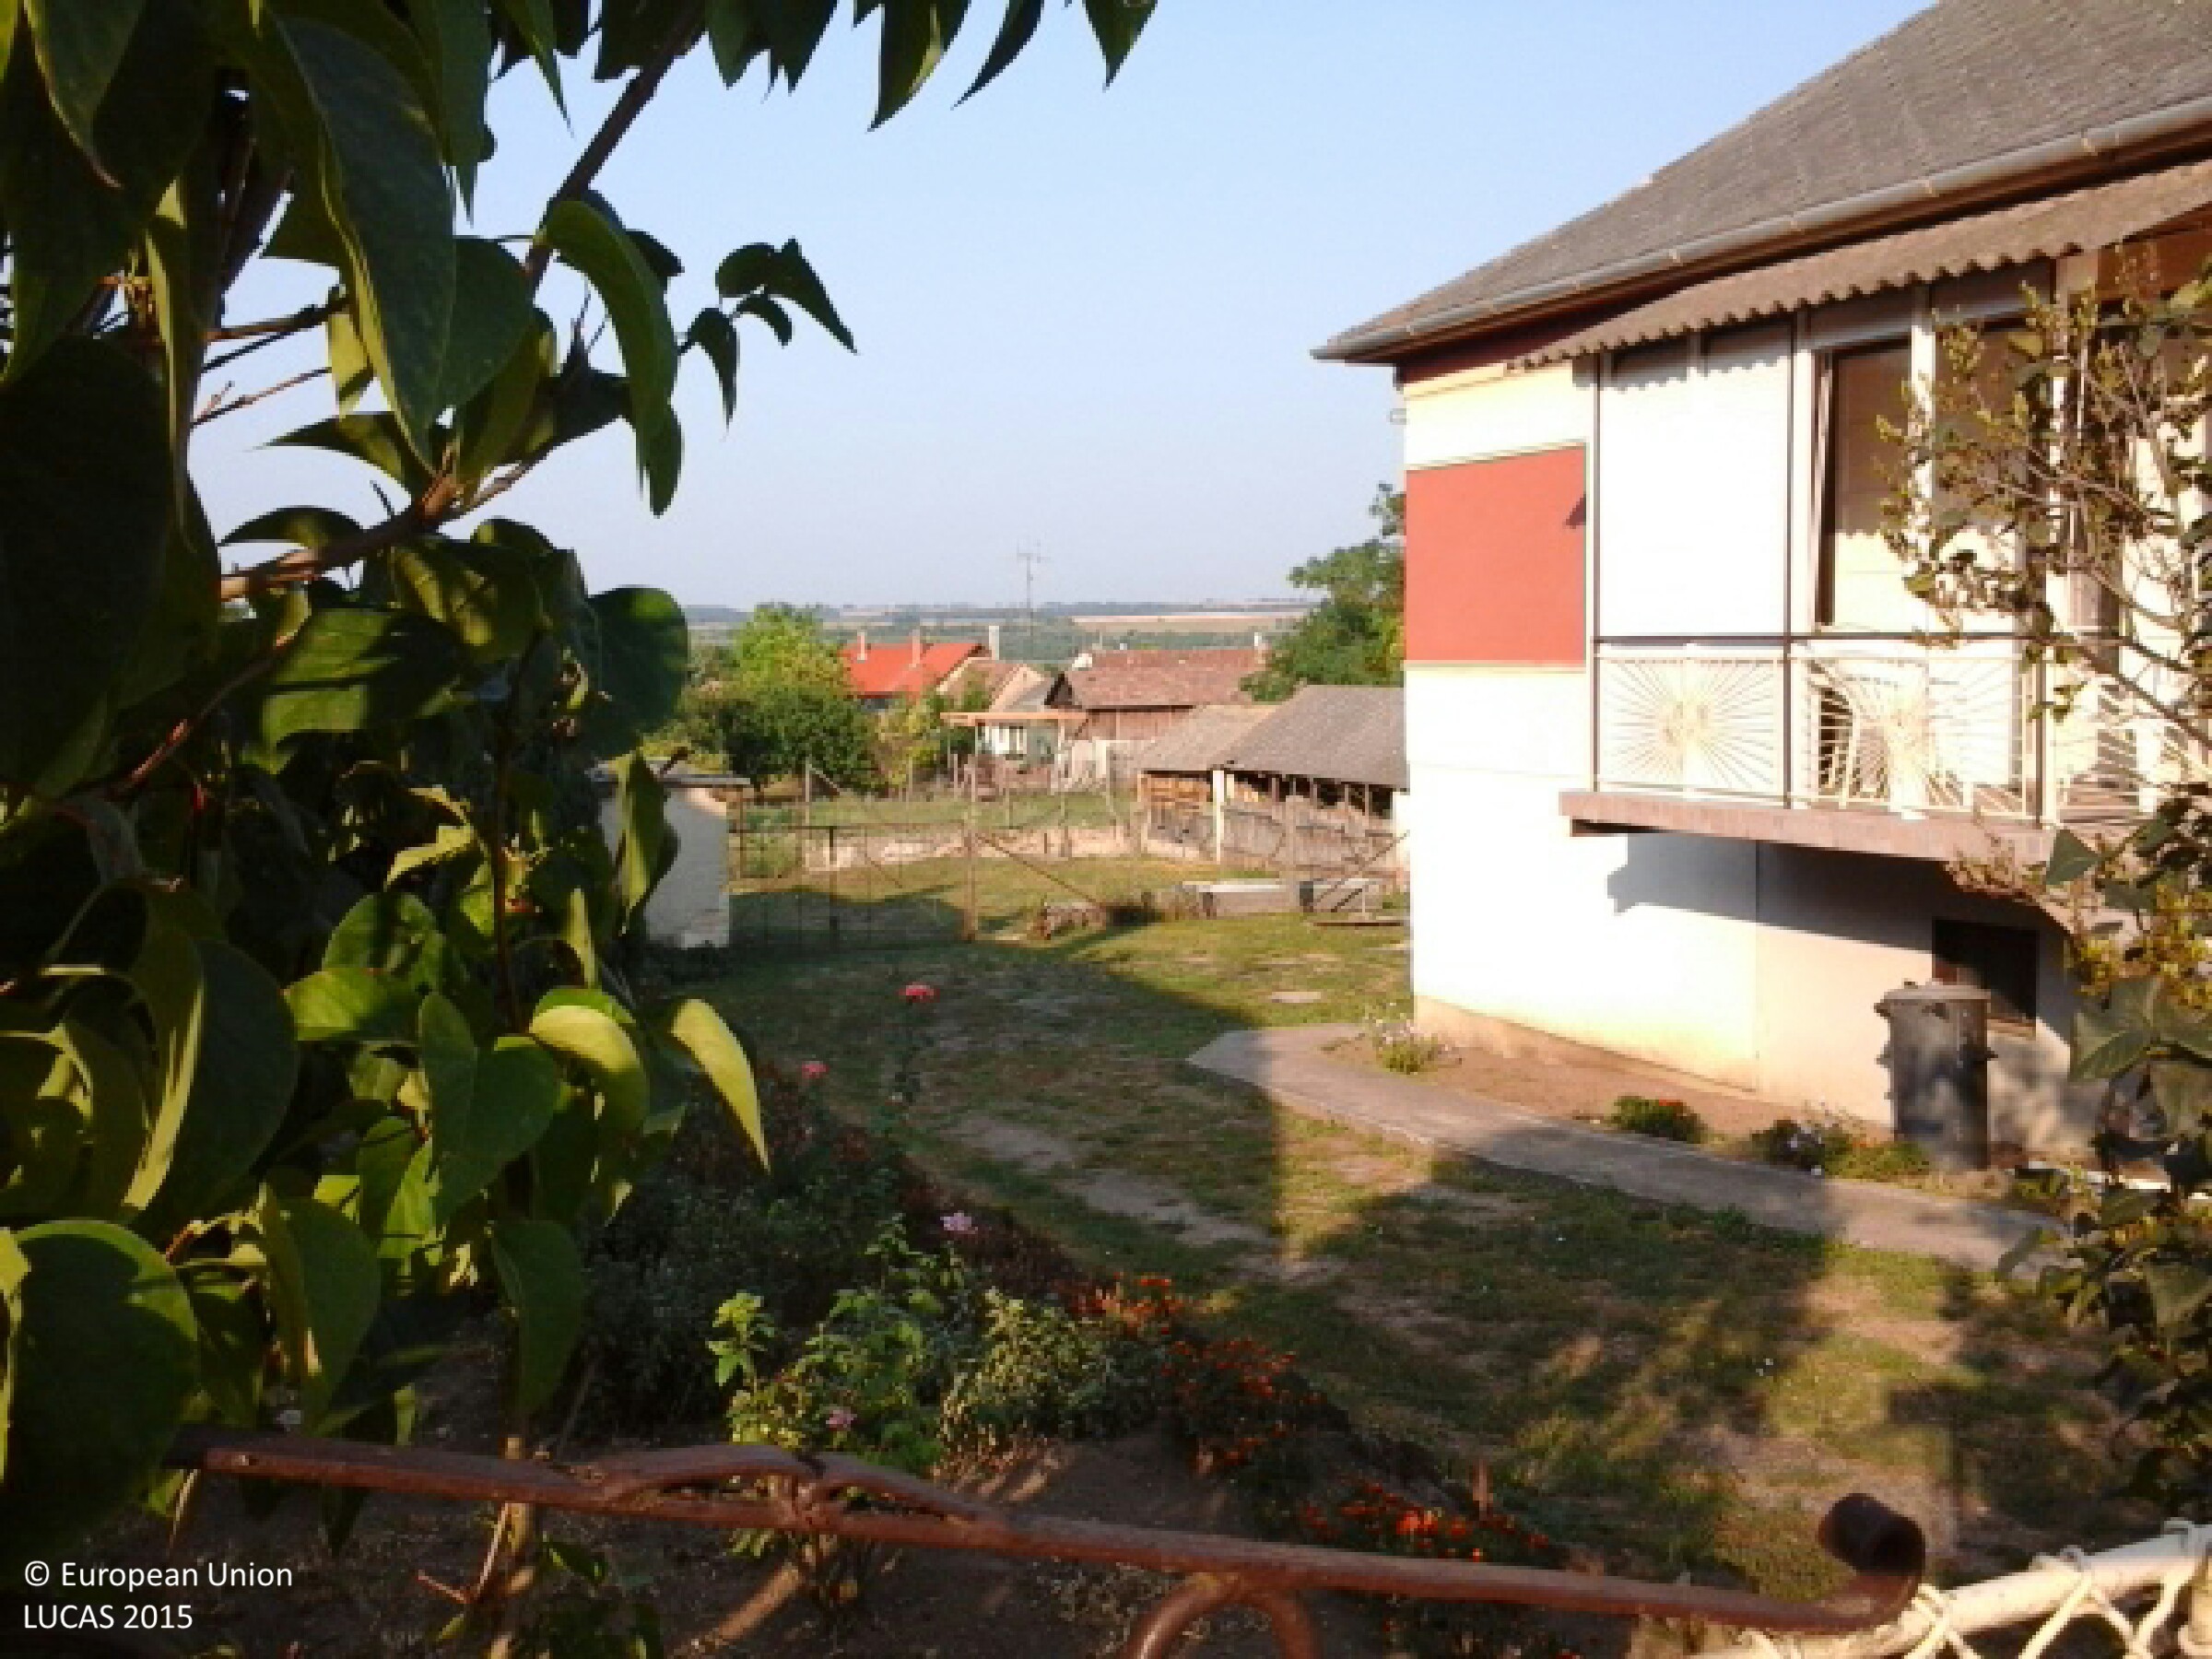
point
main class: Grassland
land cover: Grassland without tree/shrub cover
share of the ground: > 75 %
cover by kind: herbaceous plants 95 %, shrubs 5 %
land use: Residential
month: August
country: HU
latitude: 47.2806
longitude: 18.4873
